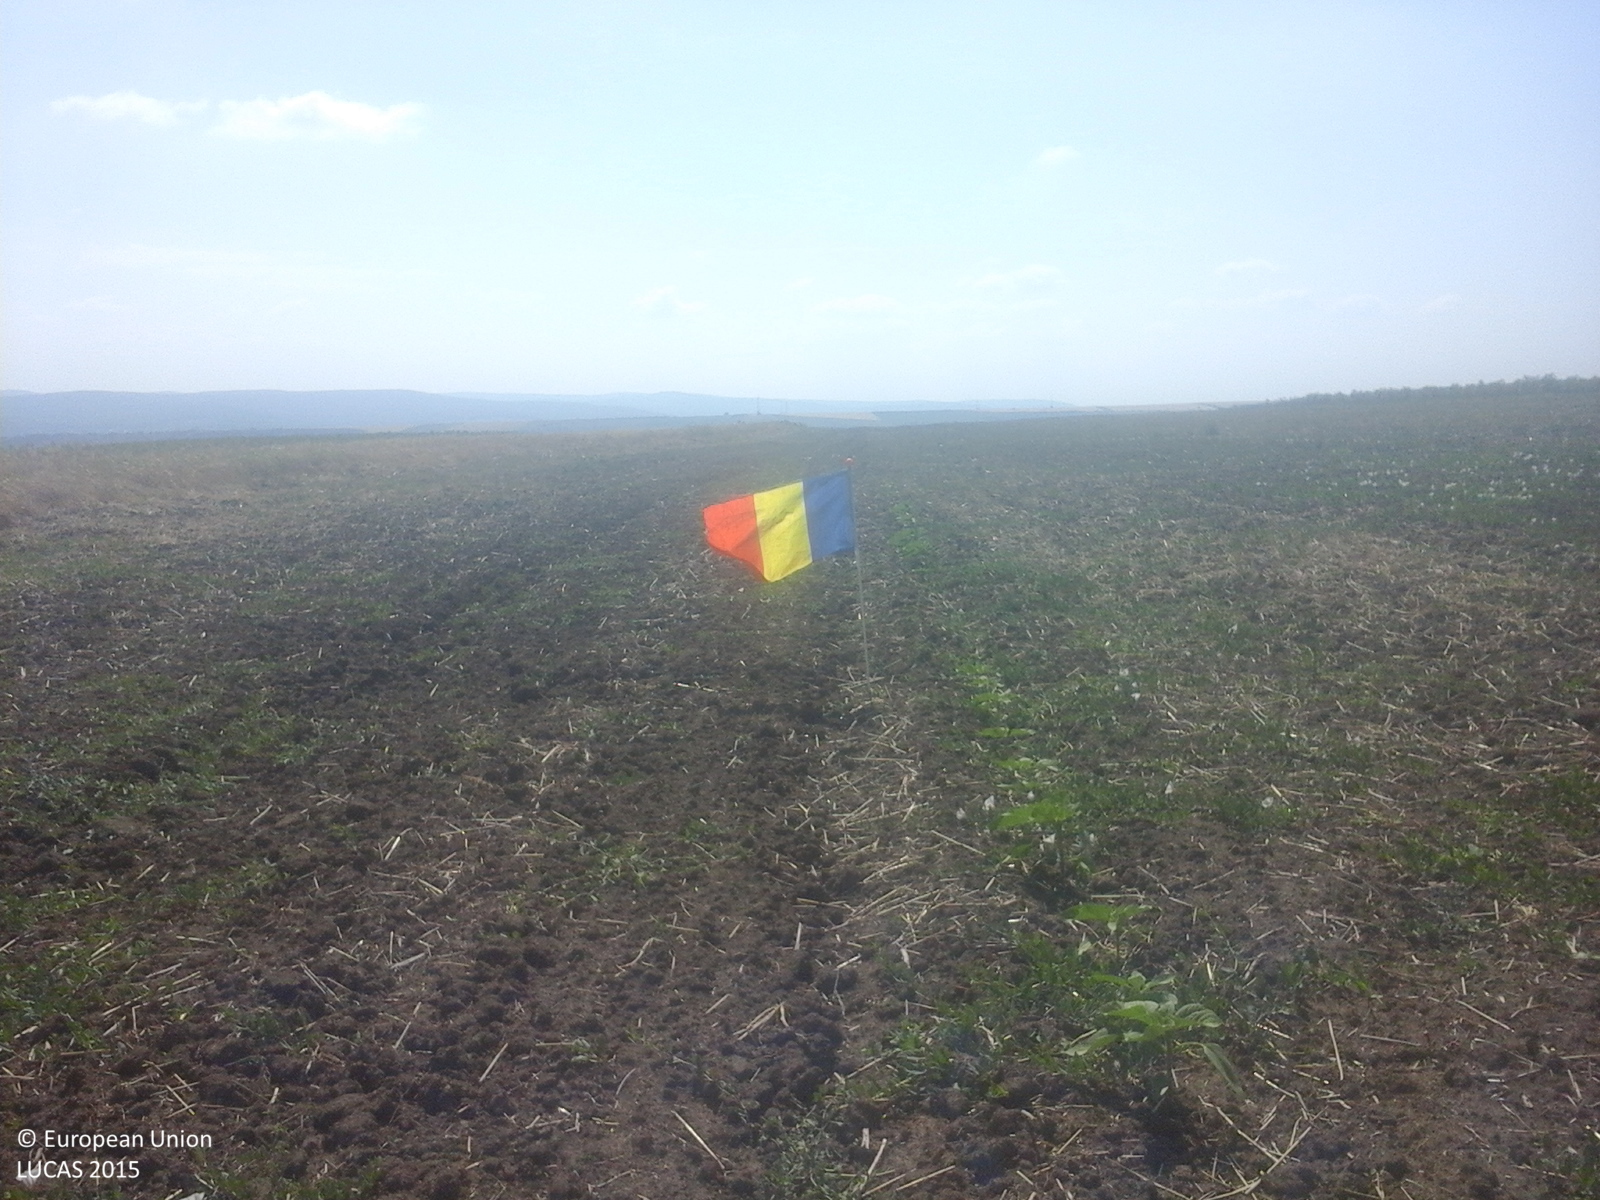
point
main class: Grassland
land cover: Spontaneously vegetated surfaces
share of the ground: < 10 %
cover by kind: herbaceous plants 100 %
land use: Fallow land
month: June
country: RO
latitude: 46.8608
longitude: 27.5206
